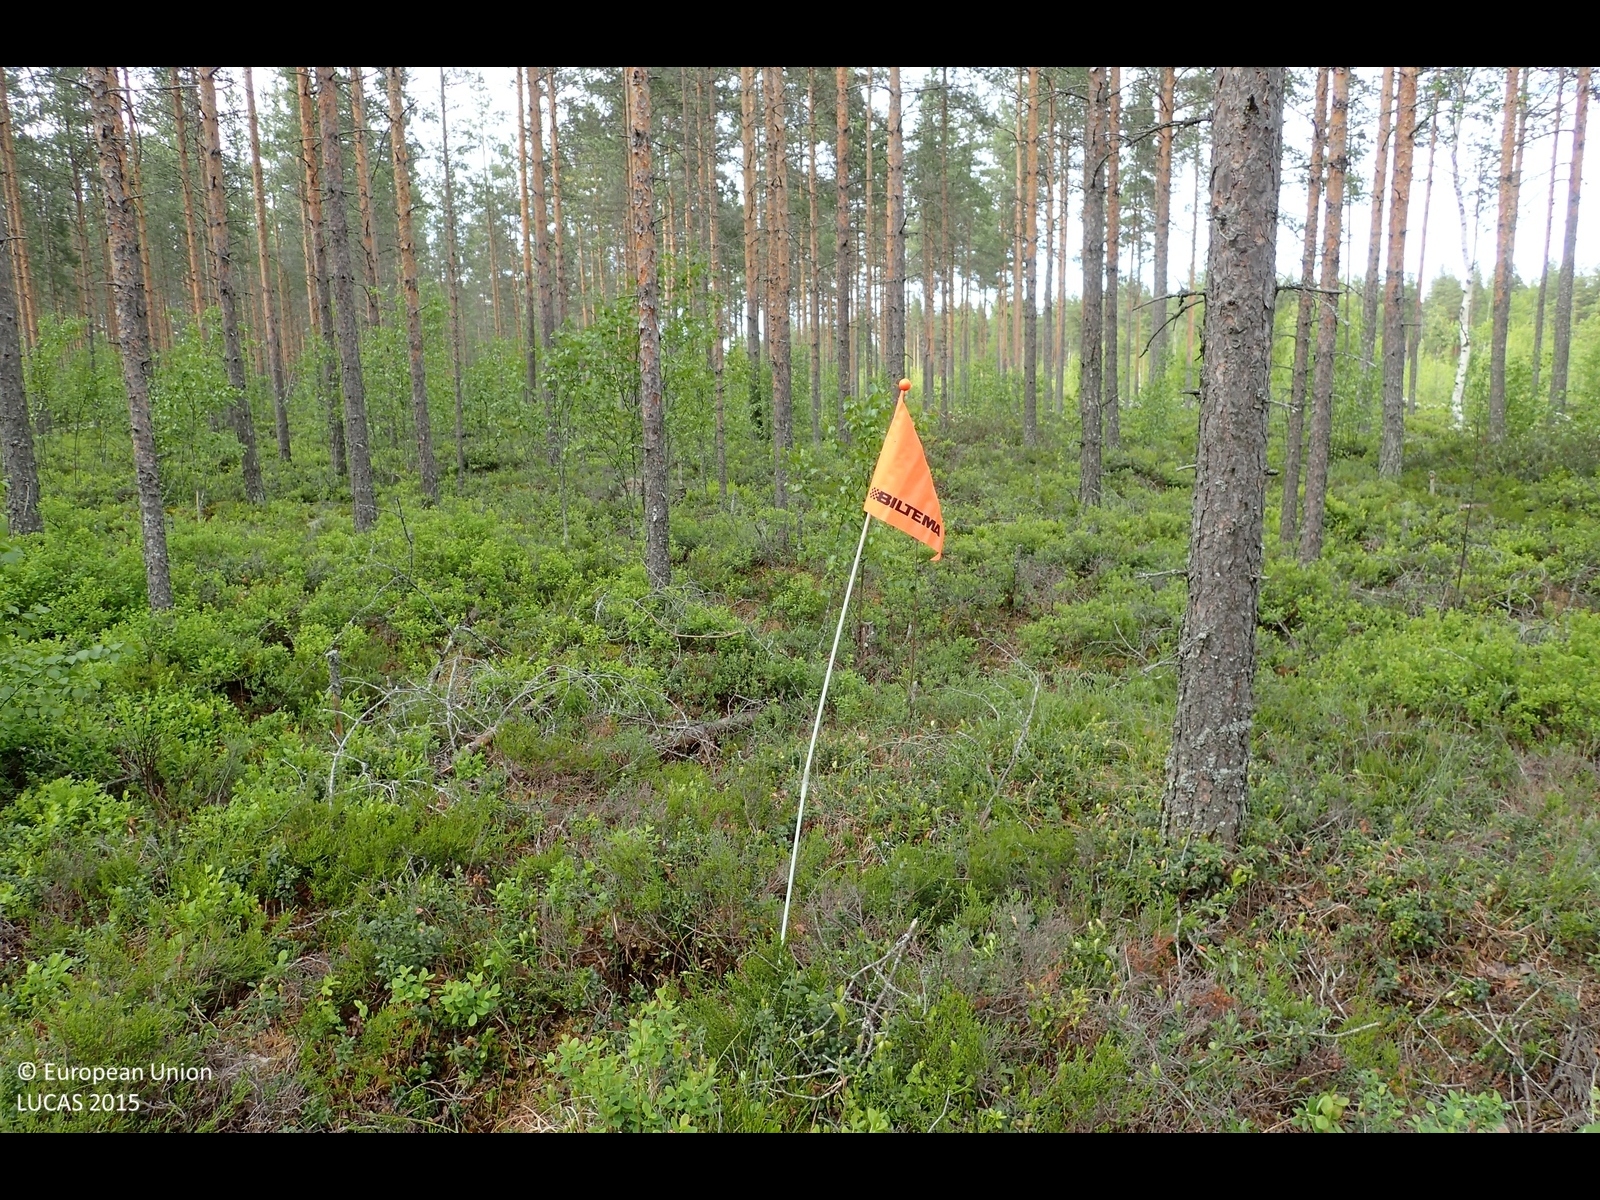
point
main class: Woodland
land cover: Pine dominated coniferous woodland
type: boreal forest
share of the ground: 25 - 50 %
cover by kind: shrubs 60 %, coniferous forest trees 35 %, broadleaved forest trees 5 %
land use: Forestry
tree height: > 5 m
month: June
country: FI
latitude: 62.4045
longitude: 23.0882
